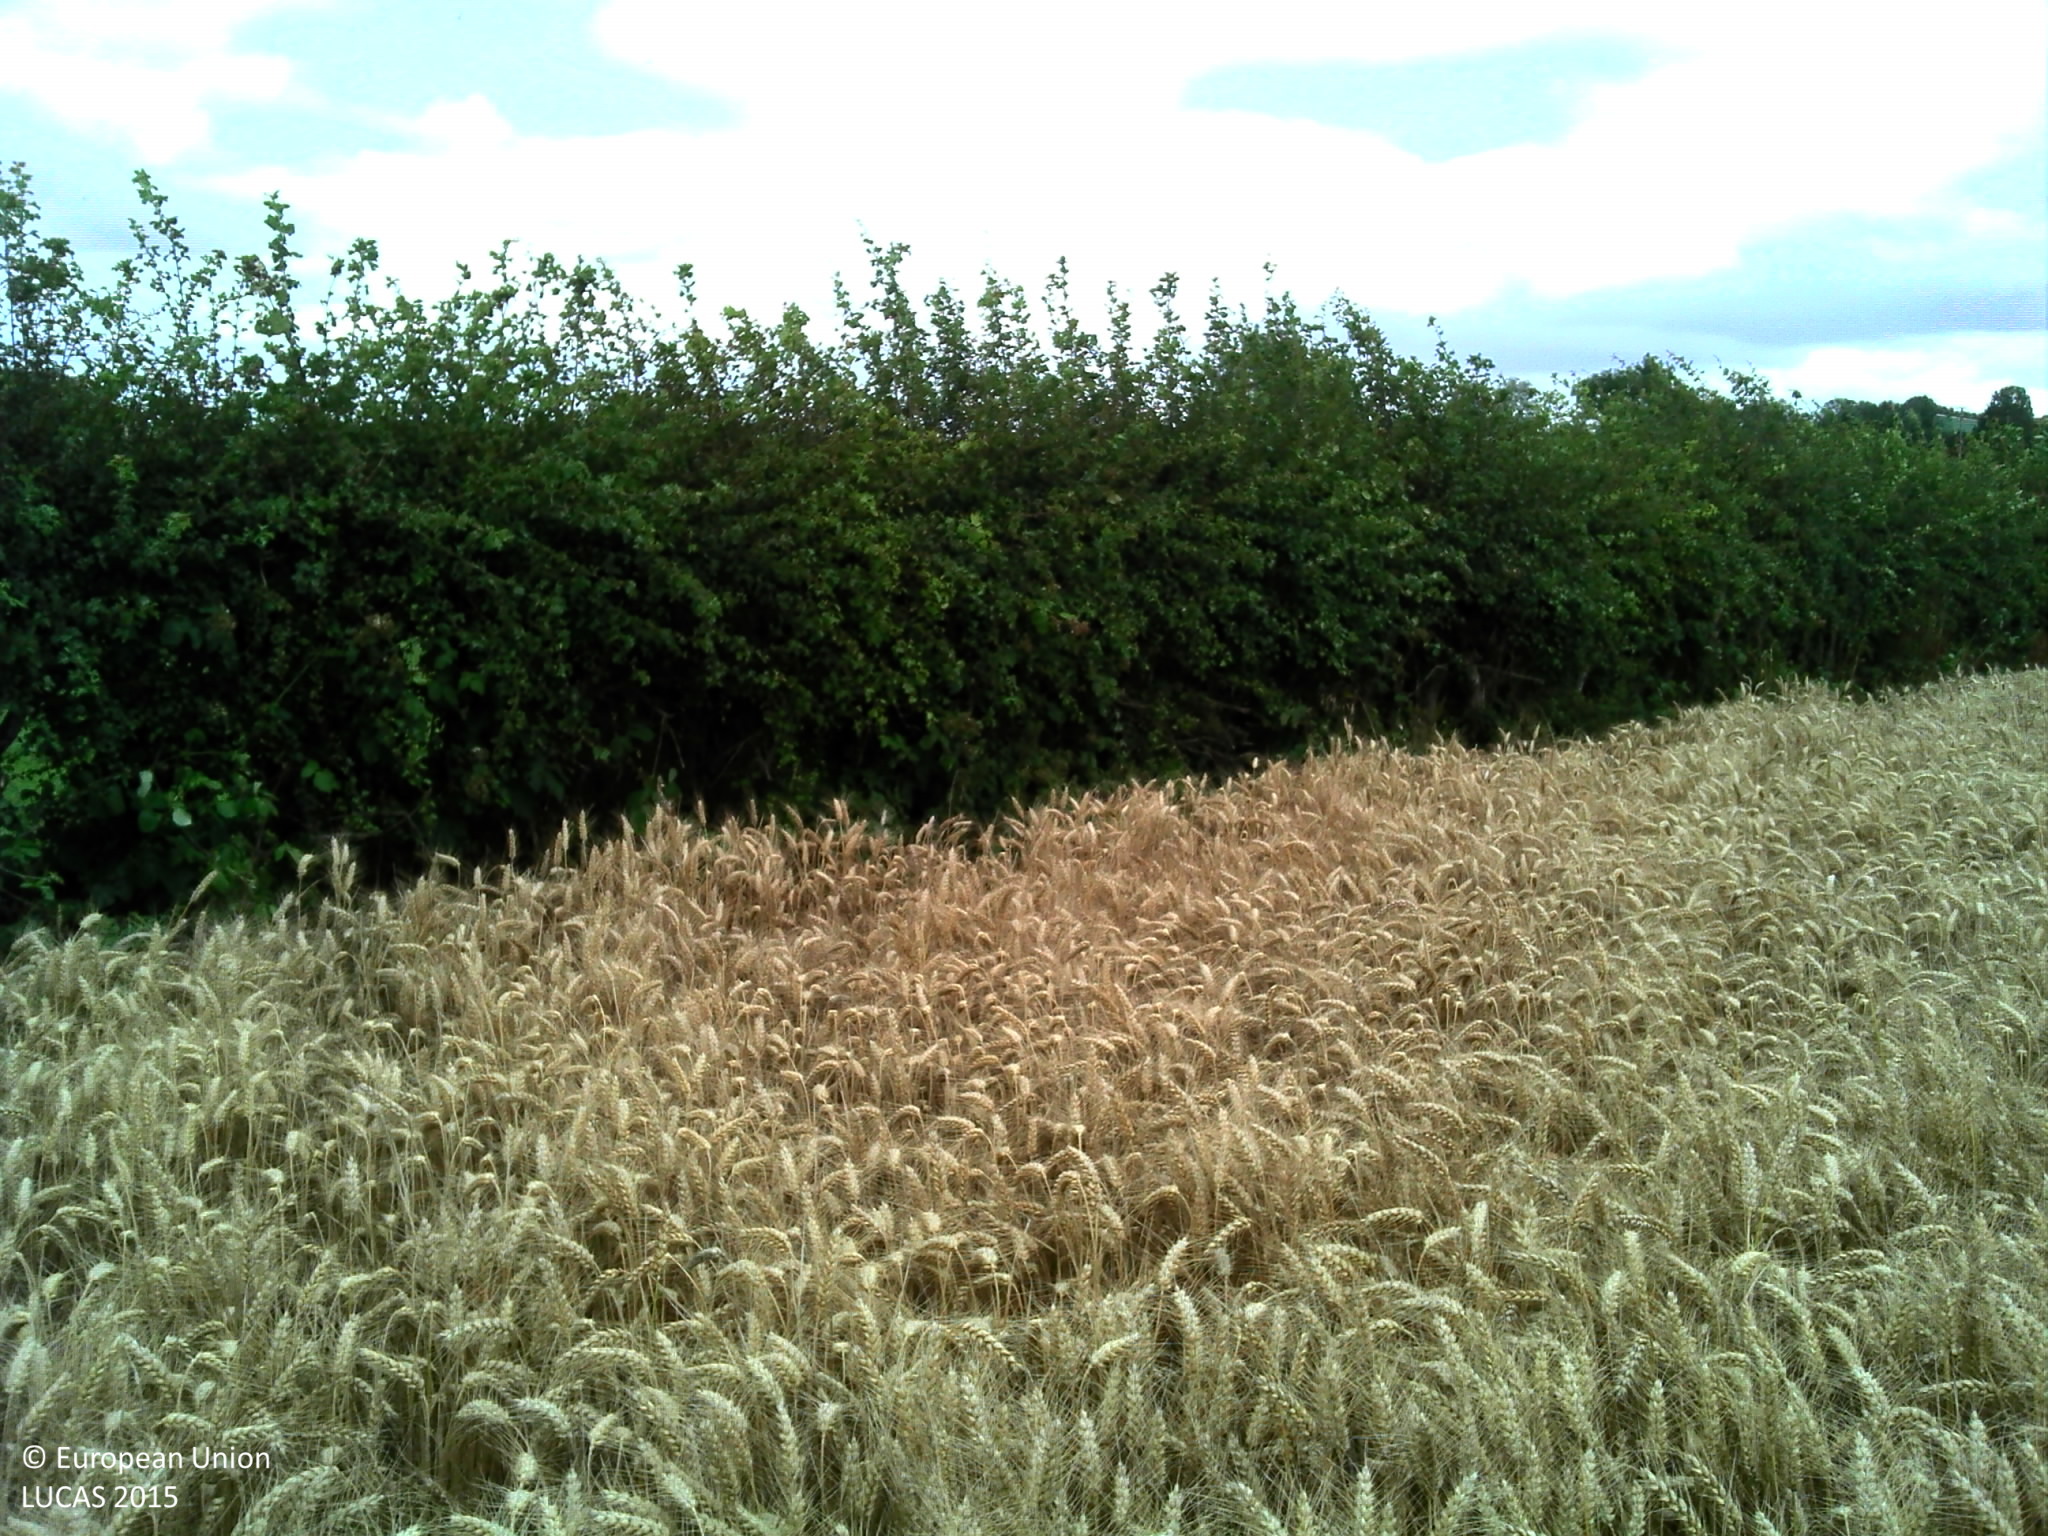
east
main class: Cropland
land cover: Common wheat
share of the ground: > 75 %
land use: Agriculture (excluding fallow land and kitchen gardens)
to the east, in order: Common wheat; Managed hedges; Grassland without tree/shrub cover; Managed hedges; Grass margins; Ditches and canals; Grass margins; Paved roads, cycling and walking lanes; Grass margins; Managed hedges; Single bushes/trees; Grassland without tree/shrub cover; Managed hedges; Grassland without tree/shrub cover; Managed hedges; Ditches and canals; Electric lines; Grass margins; Paved roads, cycling and walking lanes; Grass margins; Managed hedges; Grassland without tree/shrub cover
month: July
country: FR
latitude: 50.6512
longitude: 2.1069
